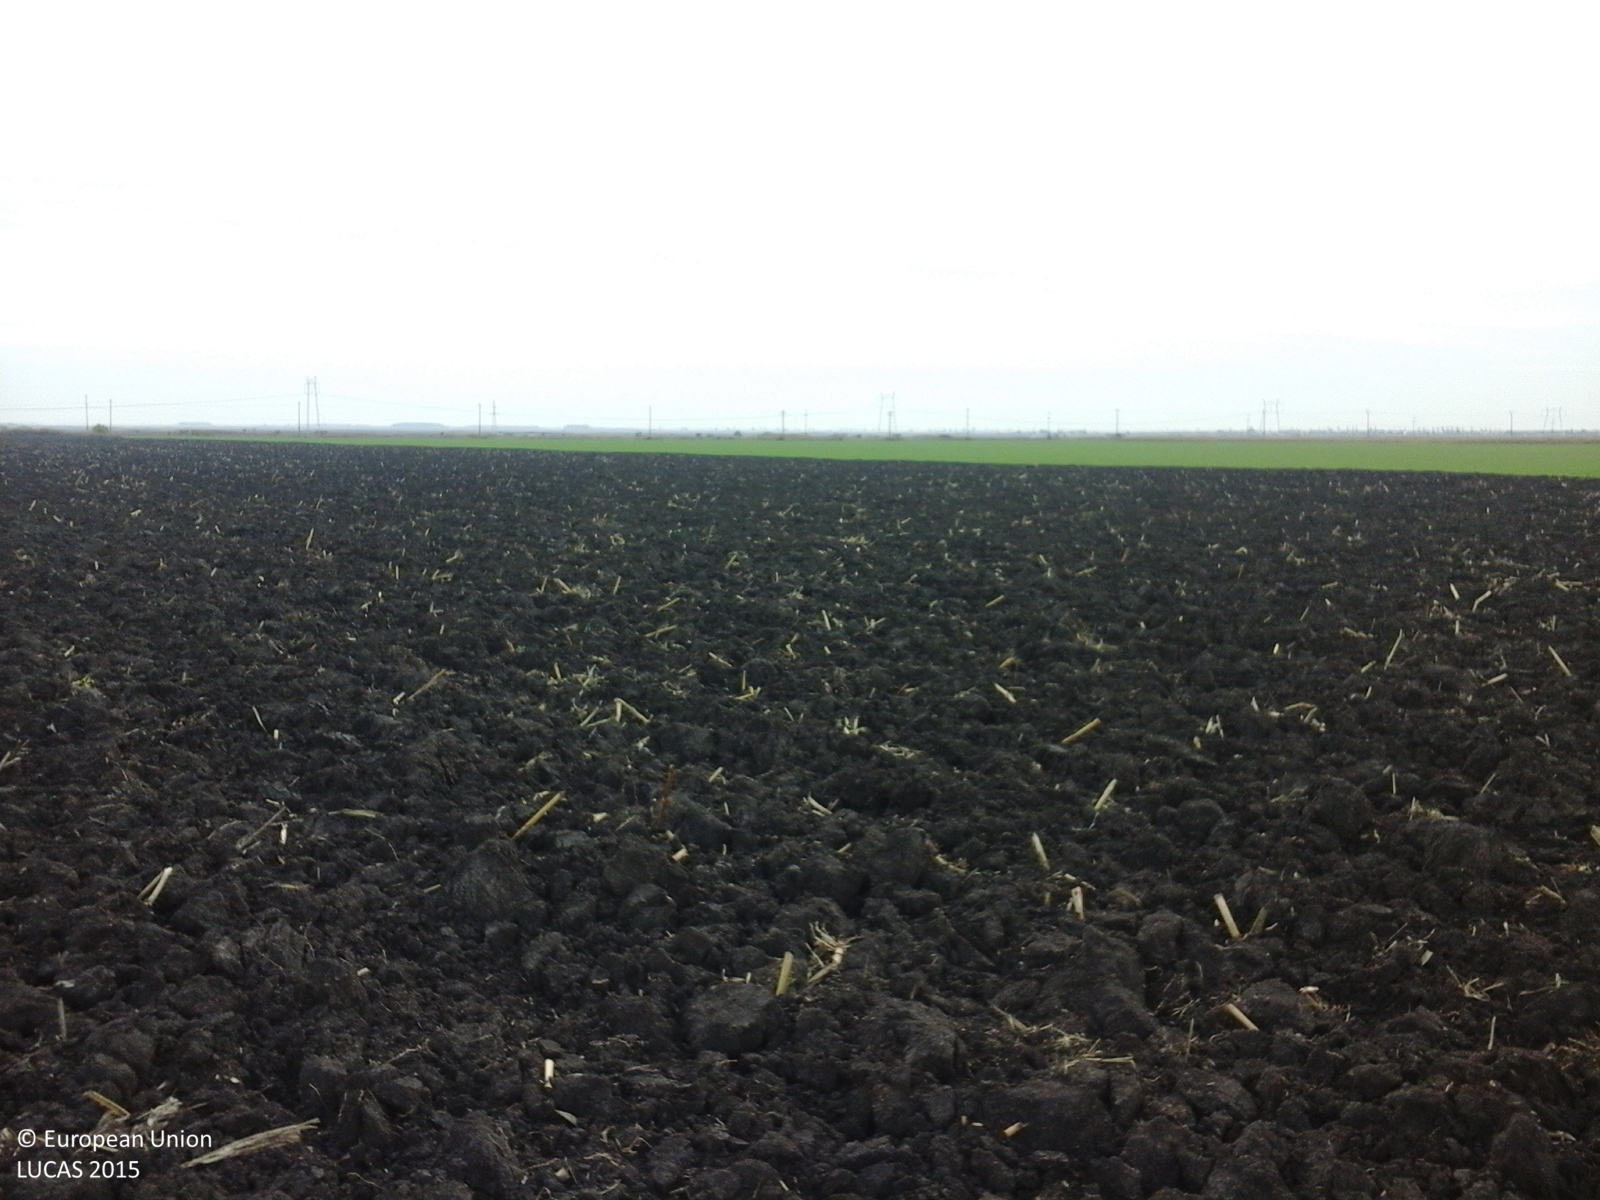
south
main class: Cropland
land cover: Maize
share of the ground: < 10 %
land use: Agriculture (excluding fallow land and kitchen gardens)
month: October
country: RO
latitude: 44.9570
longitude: 26.3290
